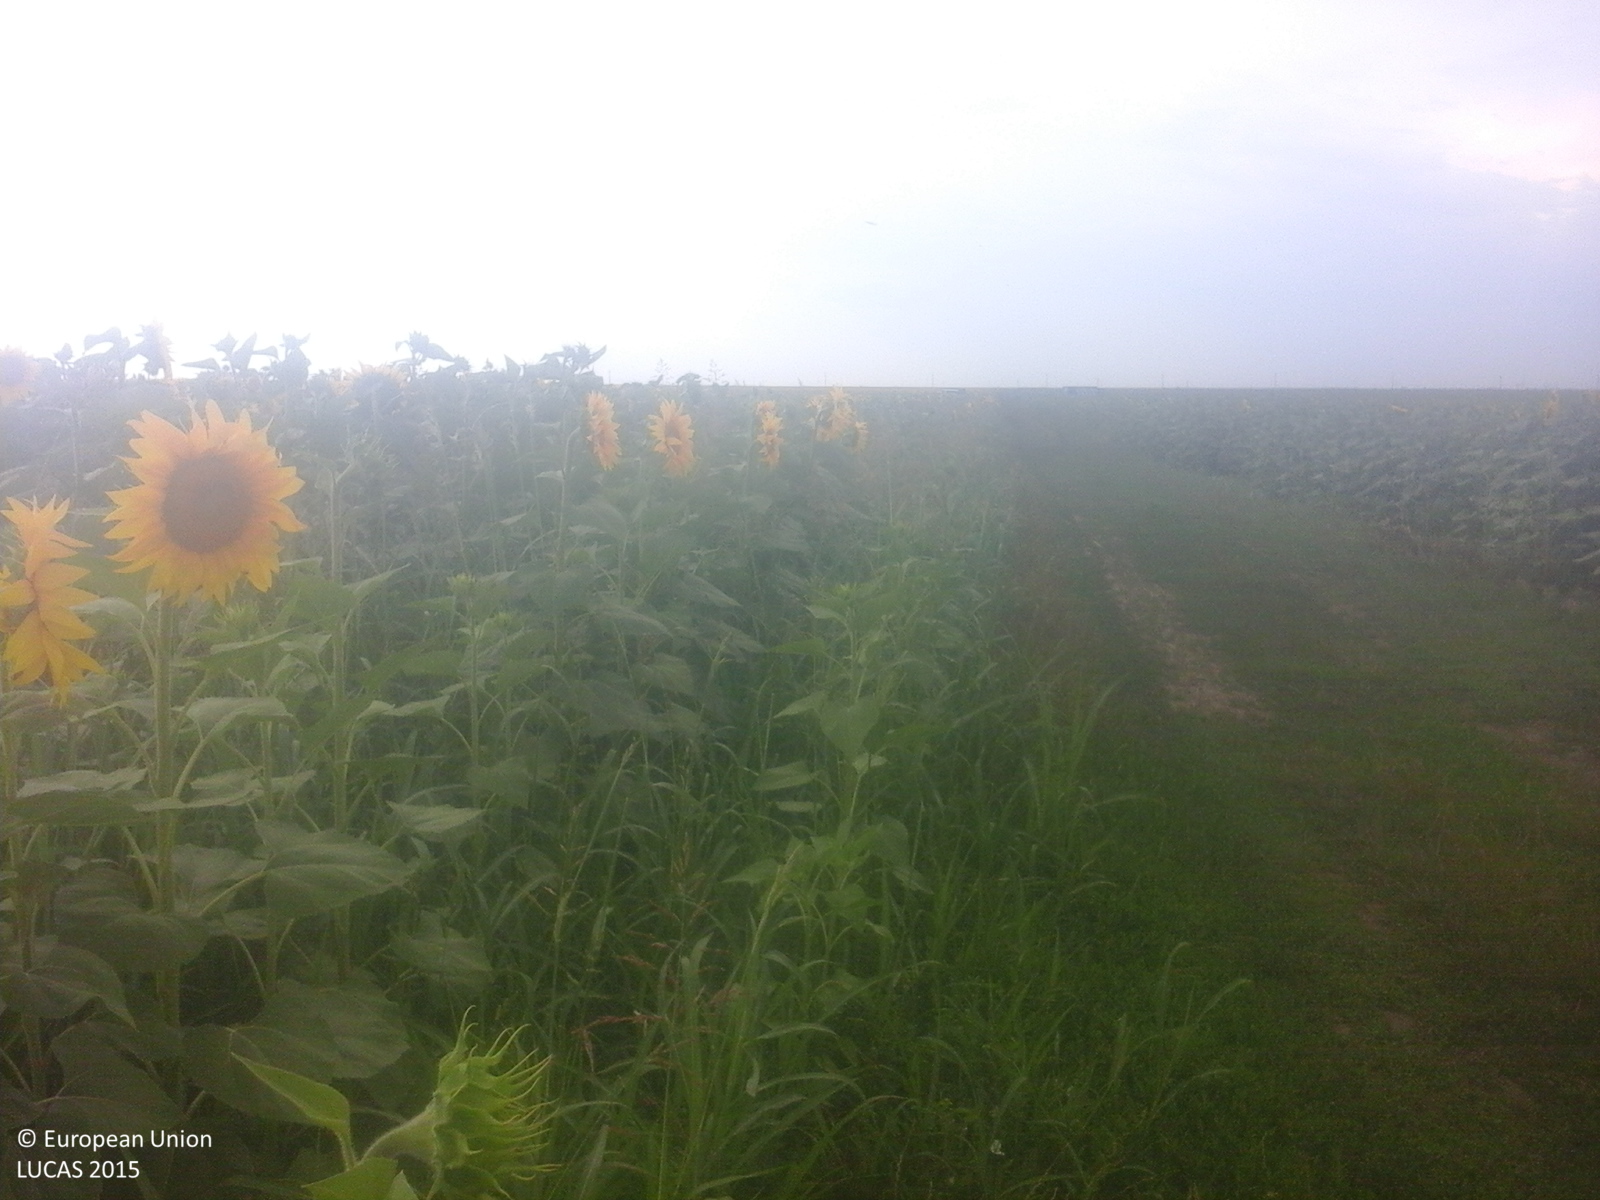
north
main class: Cropland
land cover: Sunflower
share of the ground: > 75 %
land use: Agriculture (excluding fallow land and kitchen gardens)
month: July
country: RO
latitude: 43.7848
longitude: 24.6176
